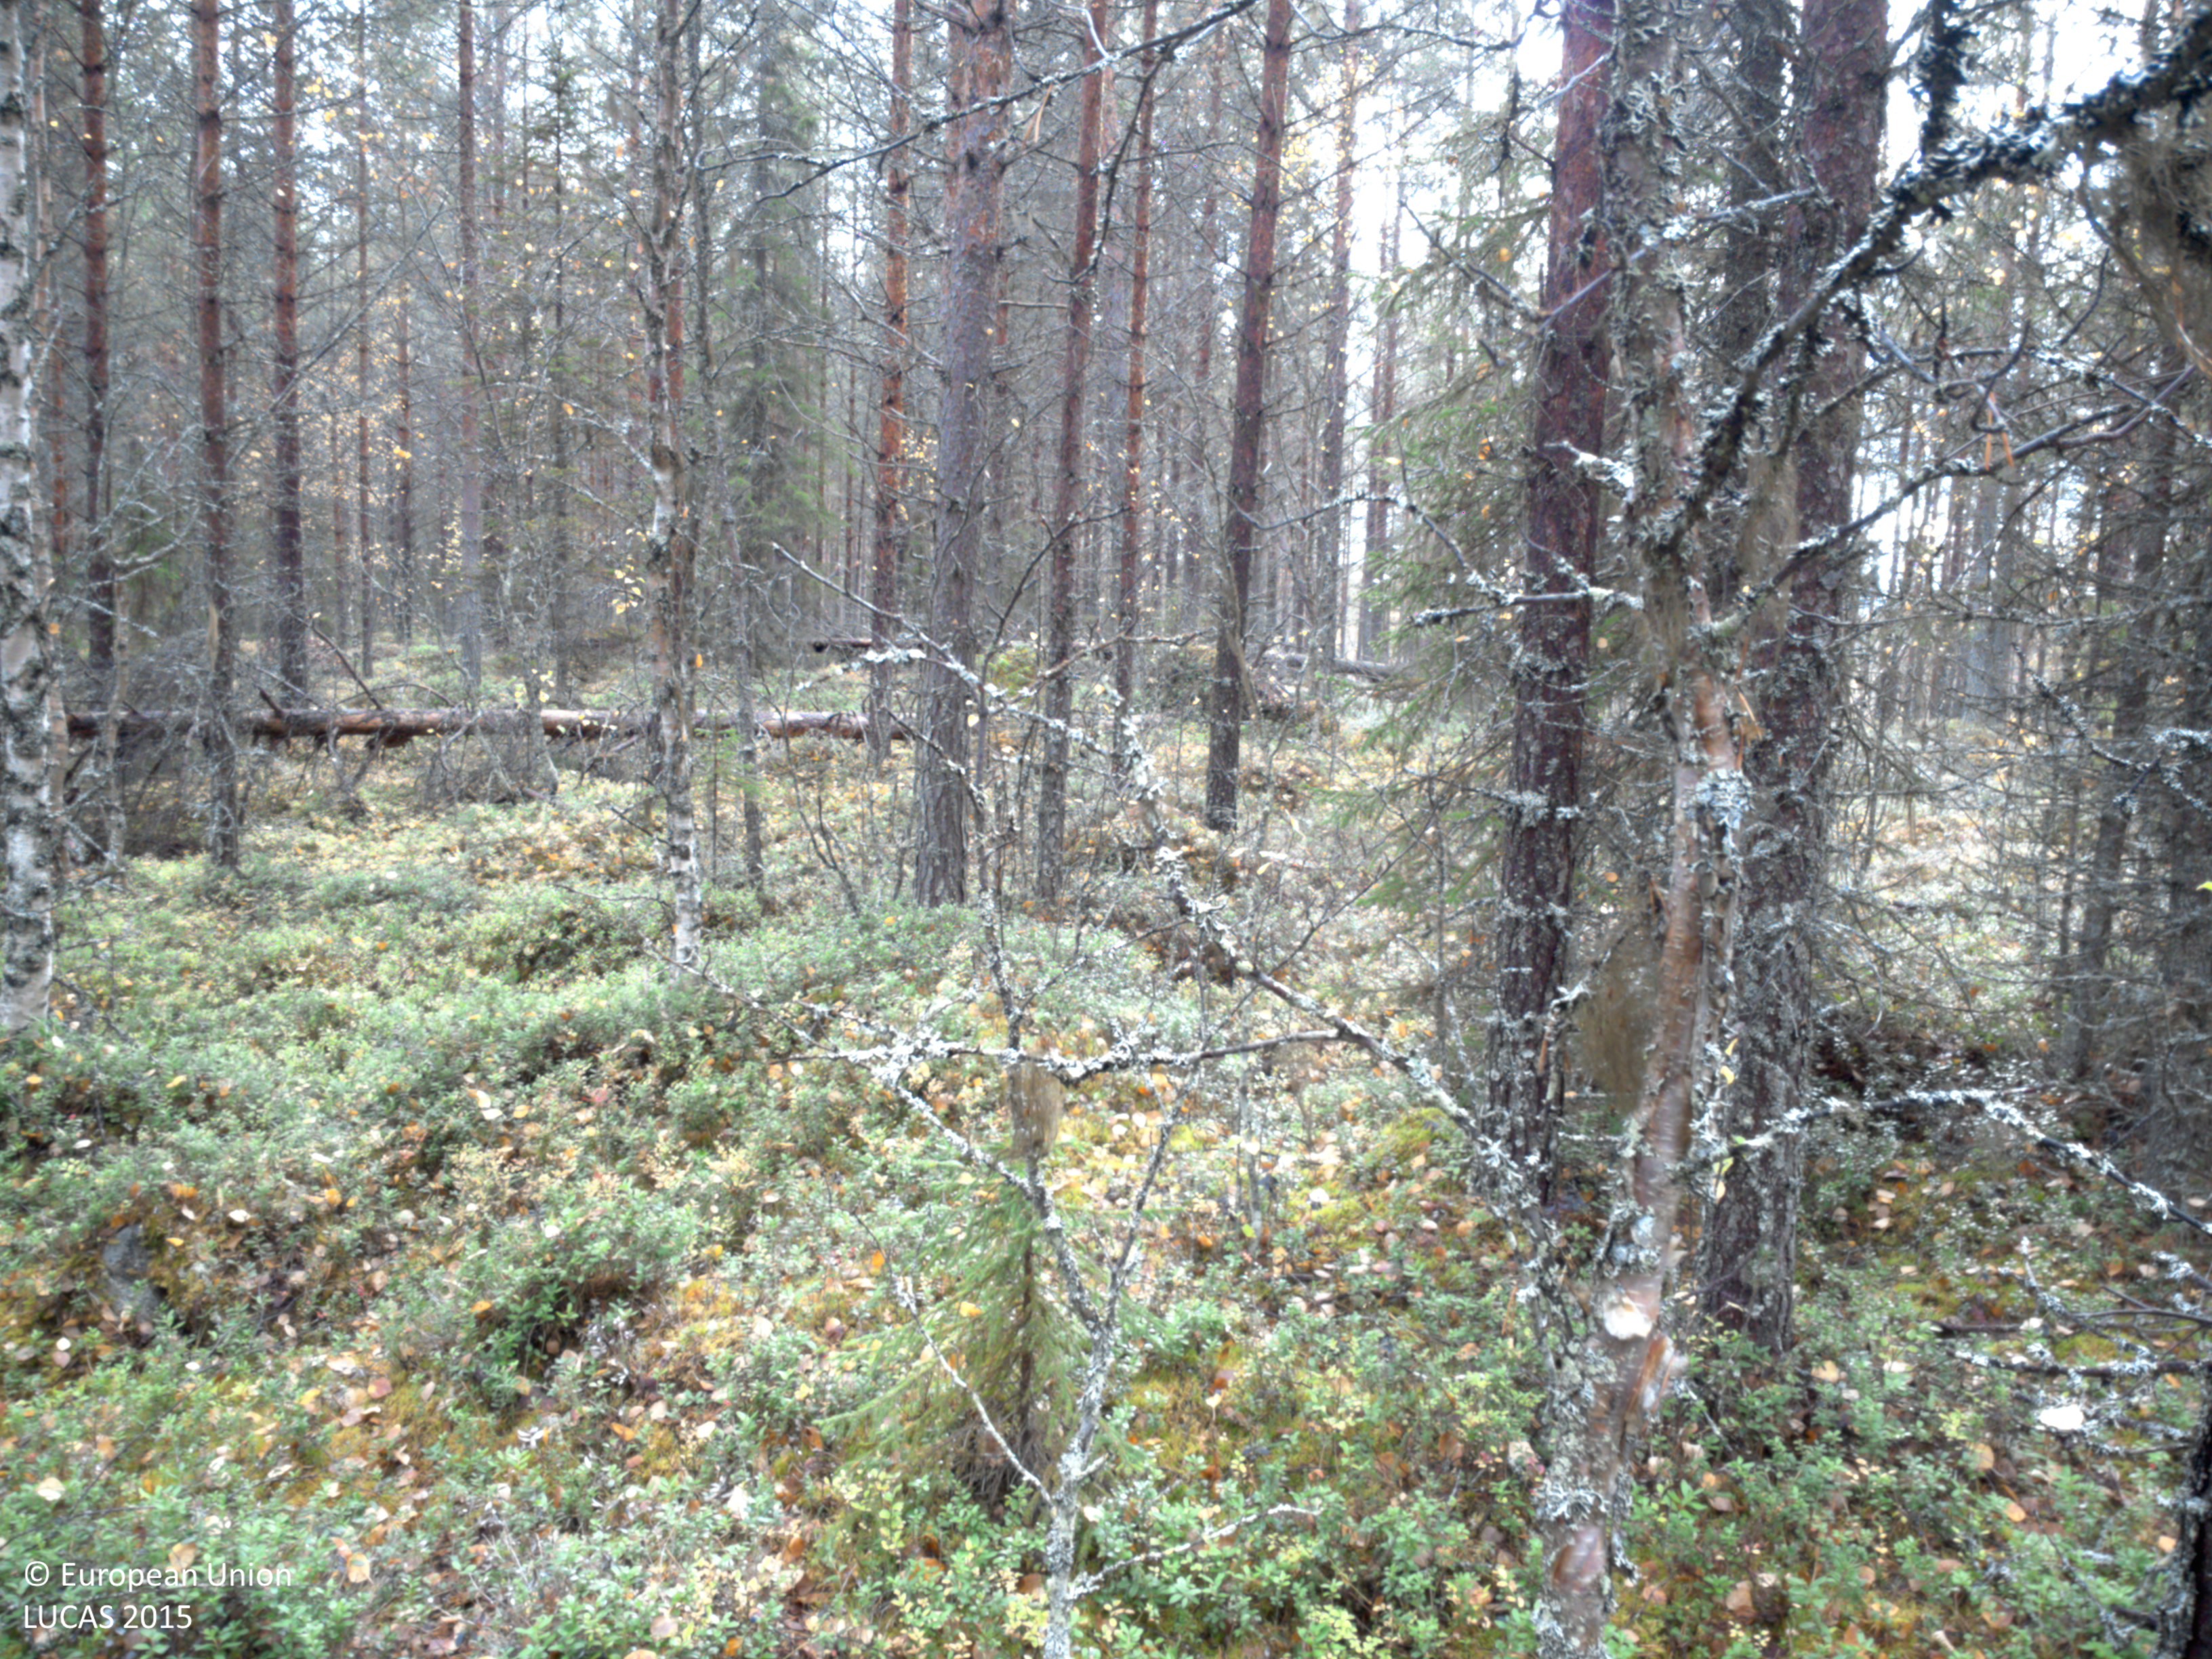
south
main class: Woodland
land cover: Pine dominated coniferous woodland
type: boreal forest
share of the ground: 50 - 75 %
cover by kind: coniferous forest trees 55 %, shrubs 20 %, lichens and mosses 10 %, broadleaved forest trees 5 %, herbaceous plants 5 %, consolidated bare surface 5 %
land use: Forestry
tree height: > 5 m
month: September
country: SE
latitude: 64.9477
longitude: 18.9185
